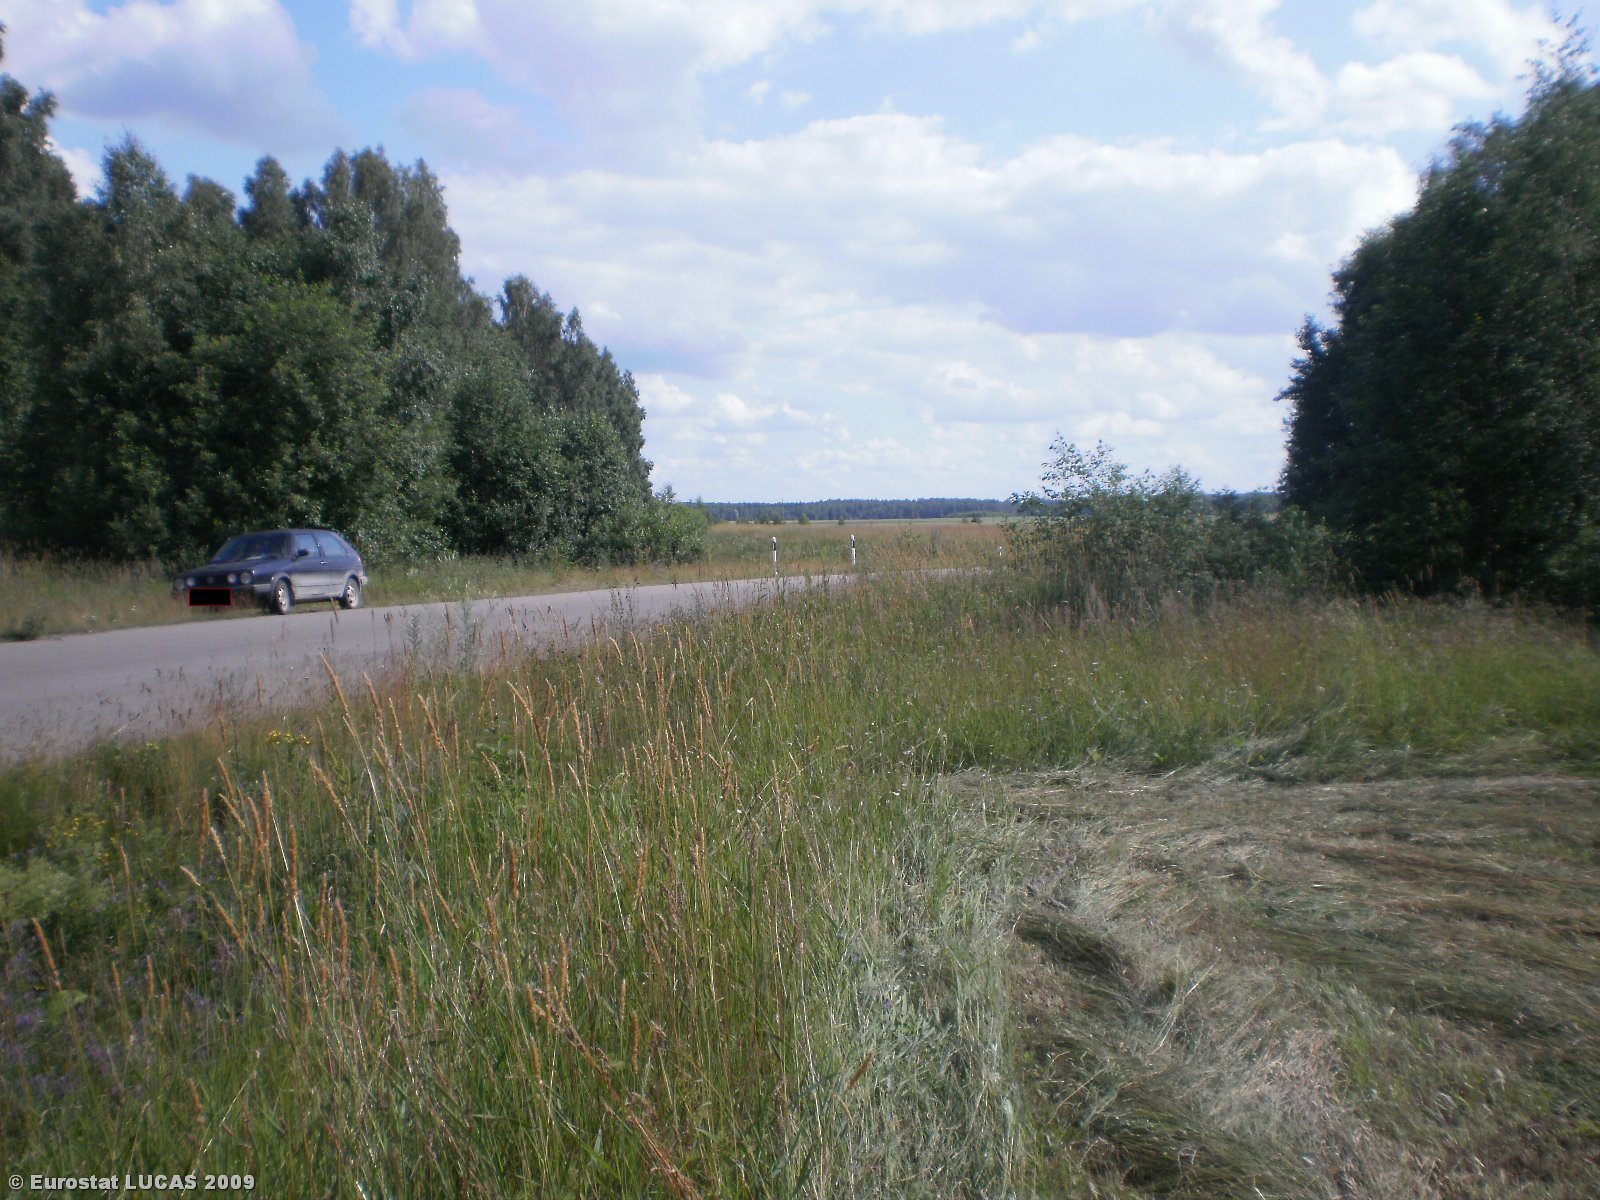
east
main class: Grassland
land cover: Grassland without tree/shrub cover
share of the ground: > 75 %
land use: Agriculture (excluding fallow land and kitchen gardens)
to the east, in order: Grassland without tree/shrub cover; Paved roads, cycling and walking lanes; Grassland without tree/shrub cover; Ditches and canals; Broadleaved woodland; Coniferous woodland
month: July
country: LT
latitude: 56.1273
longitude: 25.1221
